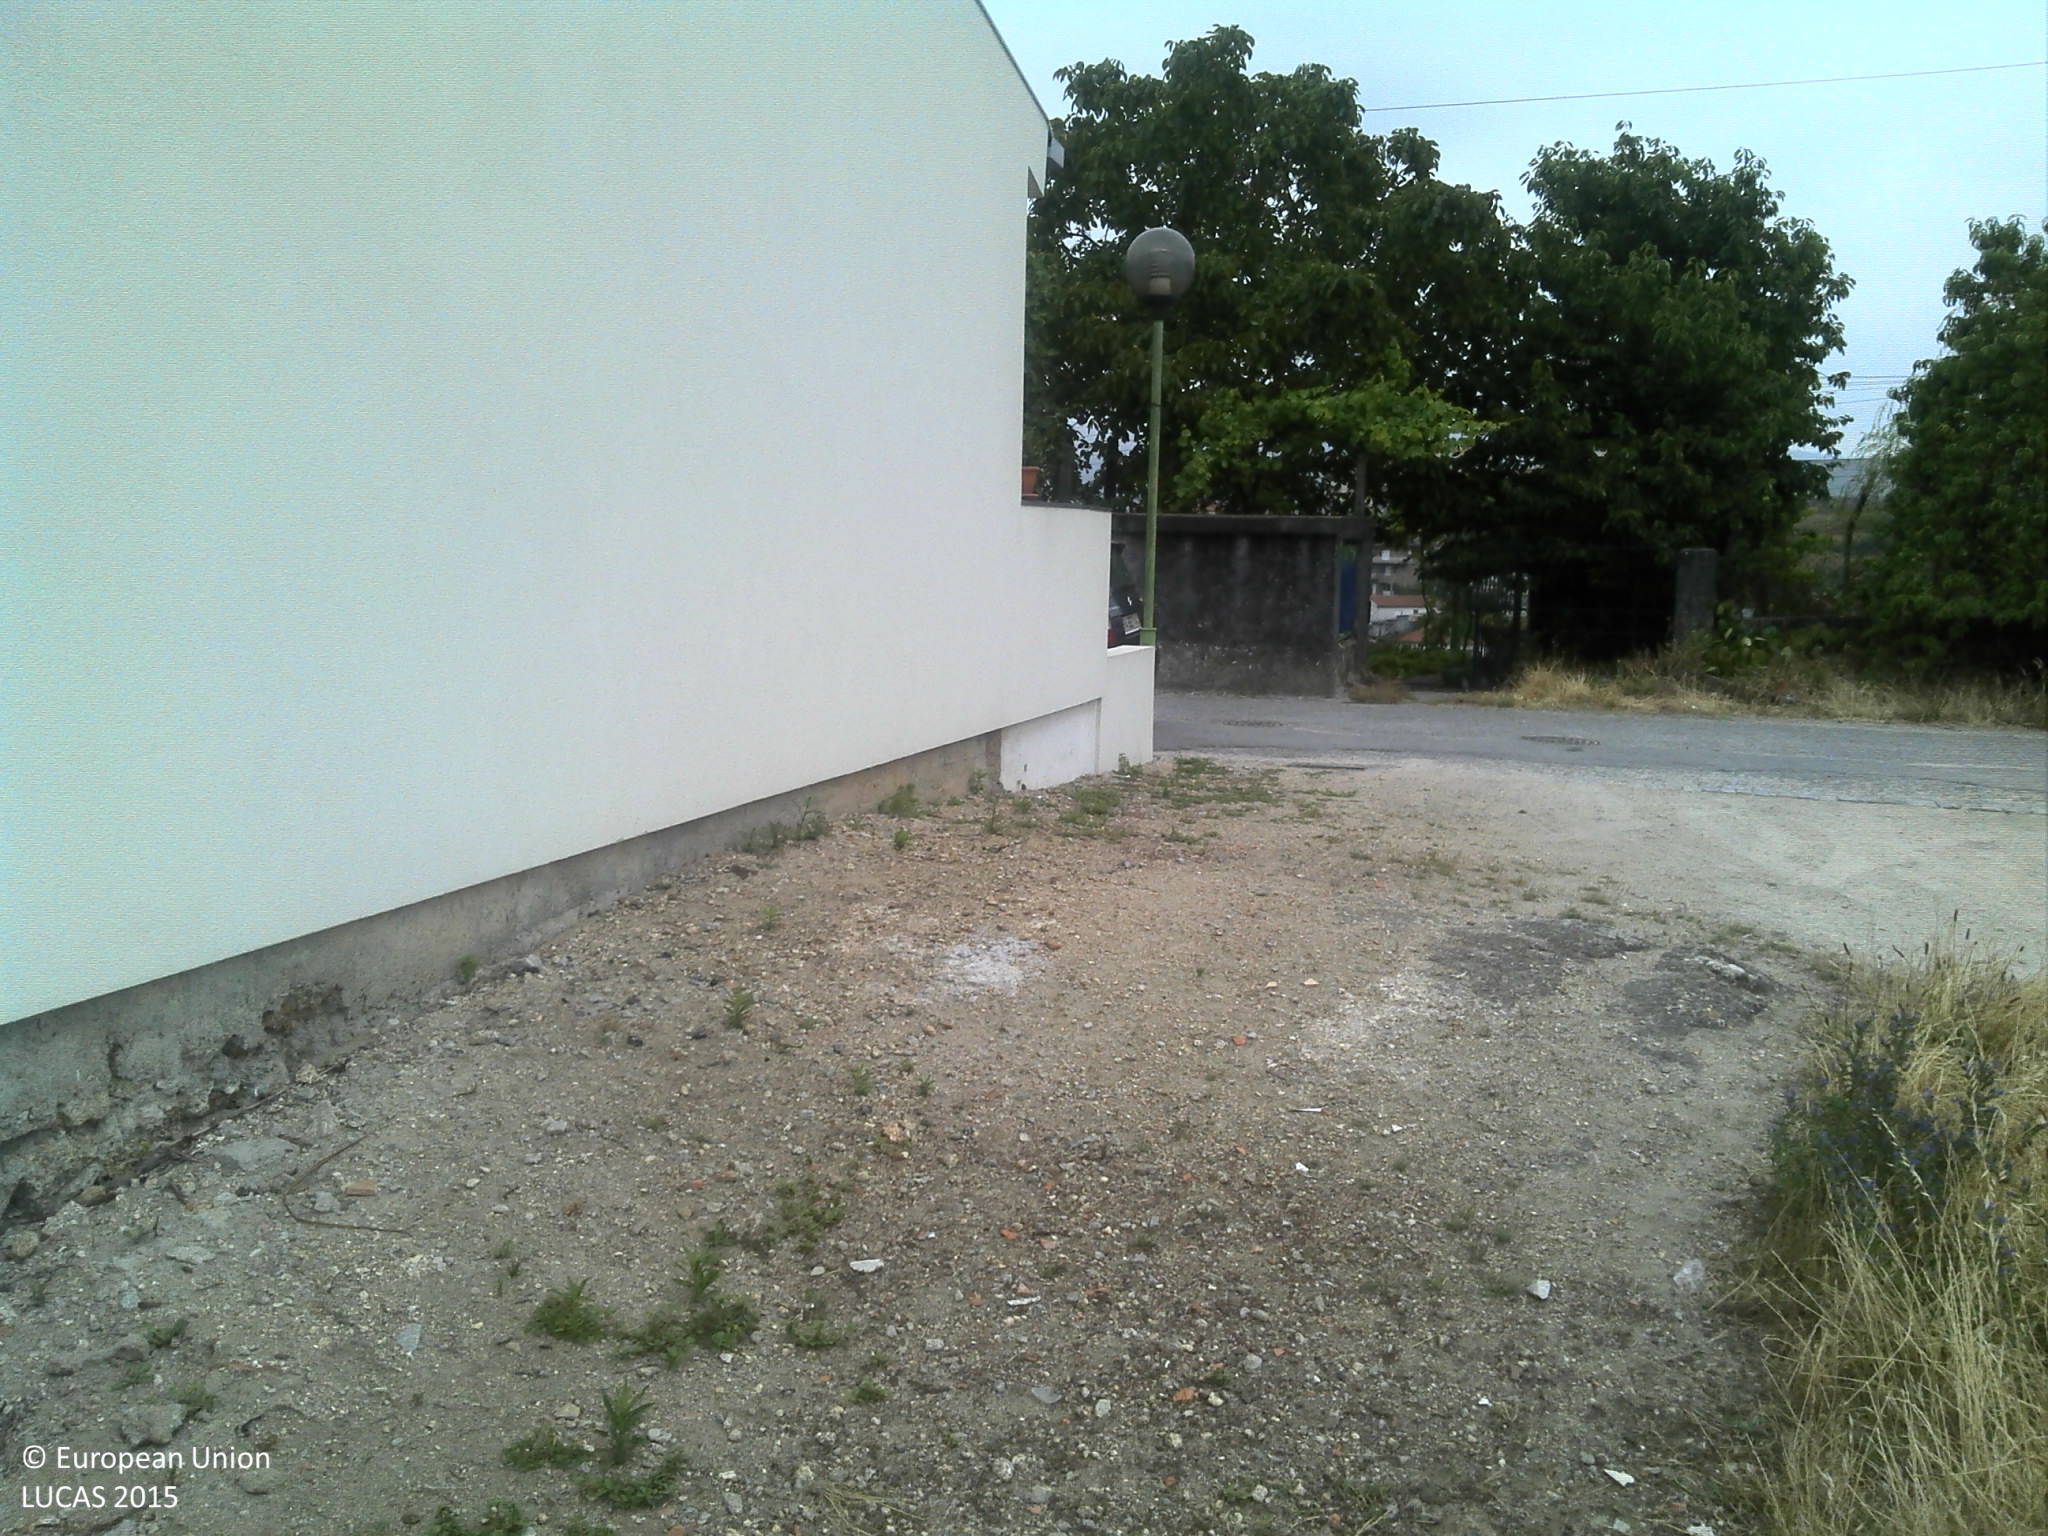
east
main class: Shrubland
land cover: Shrubland without tree cover
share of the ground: 50 - 75 %
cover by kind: herbaceous plants 60 %, unconsolidated bare surface 25 %, shrubs 15 %
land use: Residential
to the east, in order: Shrubland without tree cover; Artificial constructions in urban areas; Abandoned hedges; Fences; Other fresh vegetables; Dry stone walls; Grassland without tree/shrub cover; Artificial constructions in urban areas; Other fruit trees and berries; Other fresh vegetables; Vineyards; Grassland without tree/shrub cover; Vineyards; Maize; Vineyards; Grassland without tree/shrub cover
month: June
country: PT
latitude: 41.1820
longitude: -8.1530
